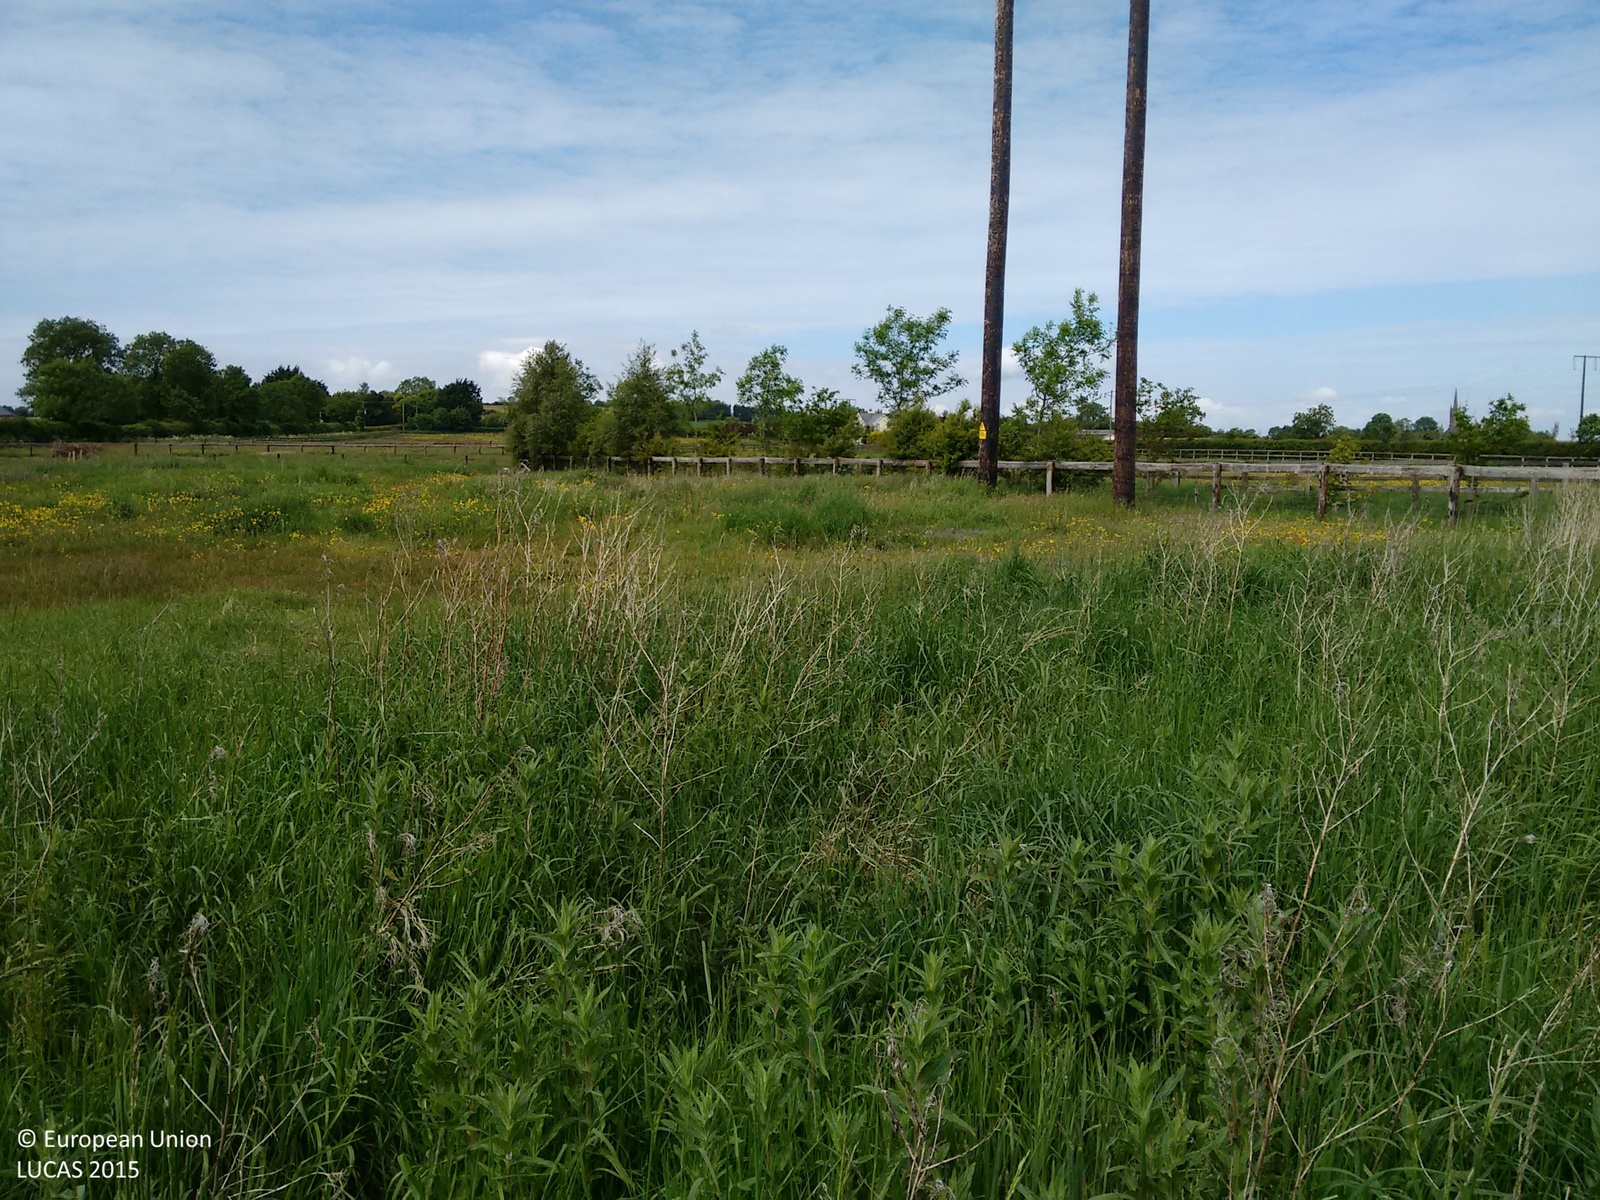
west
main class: Grassland
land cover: Grassland without tree/shrub cover
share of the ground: > 75 %
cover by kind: herbaceous plants 60 %, shrubs 5 %
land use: Agriculture (excluding fallow land and kitchen gardens)
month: June
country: IE
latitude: 53.2312
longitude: -6.9027
